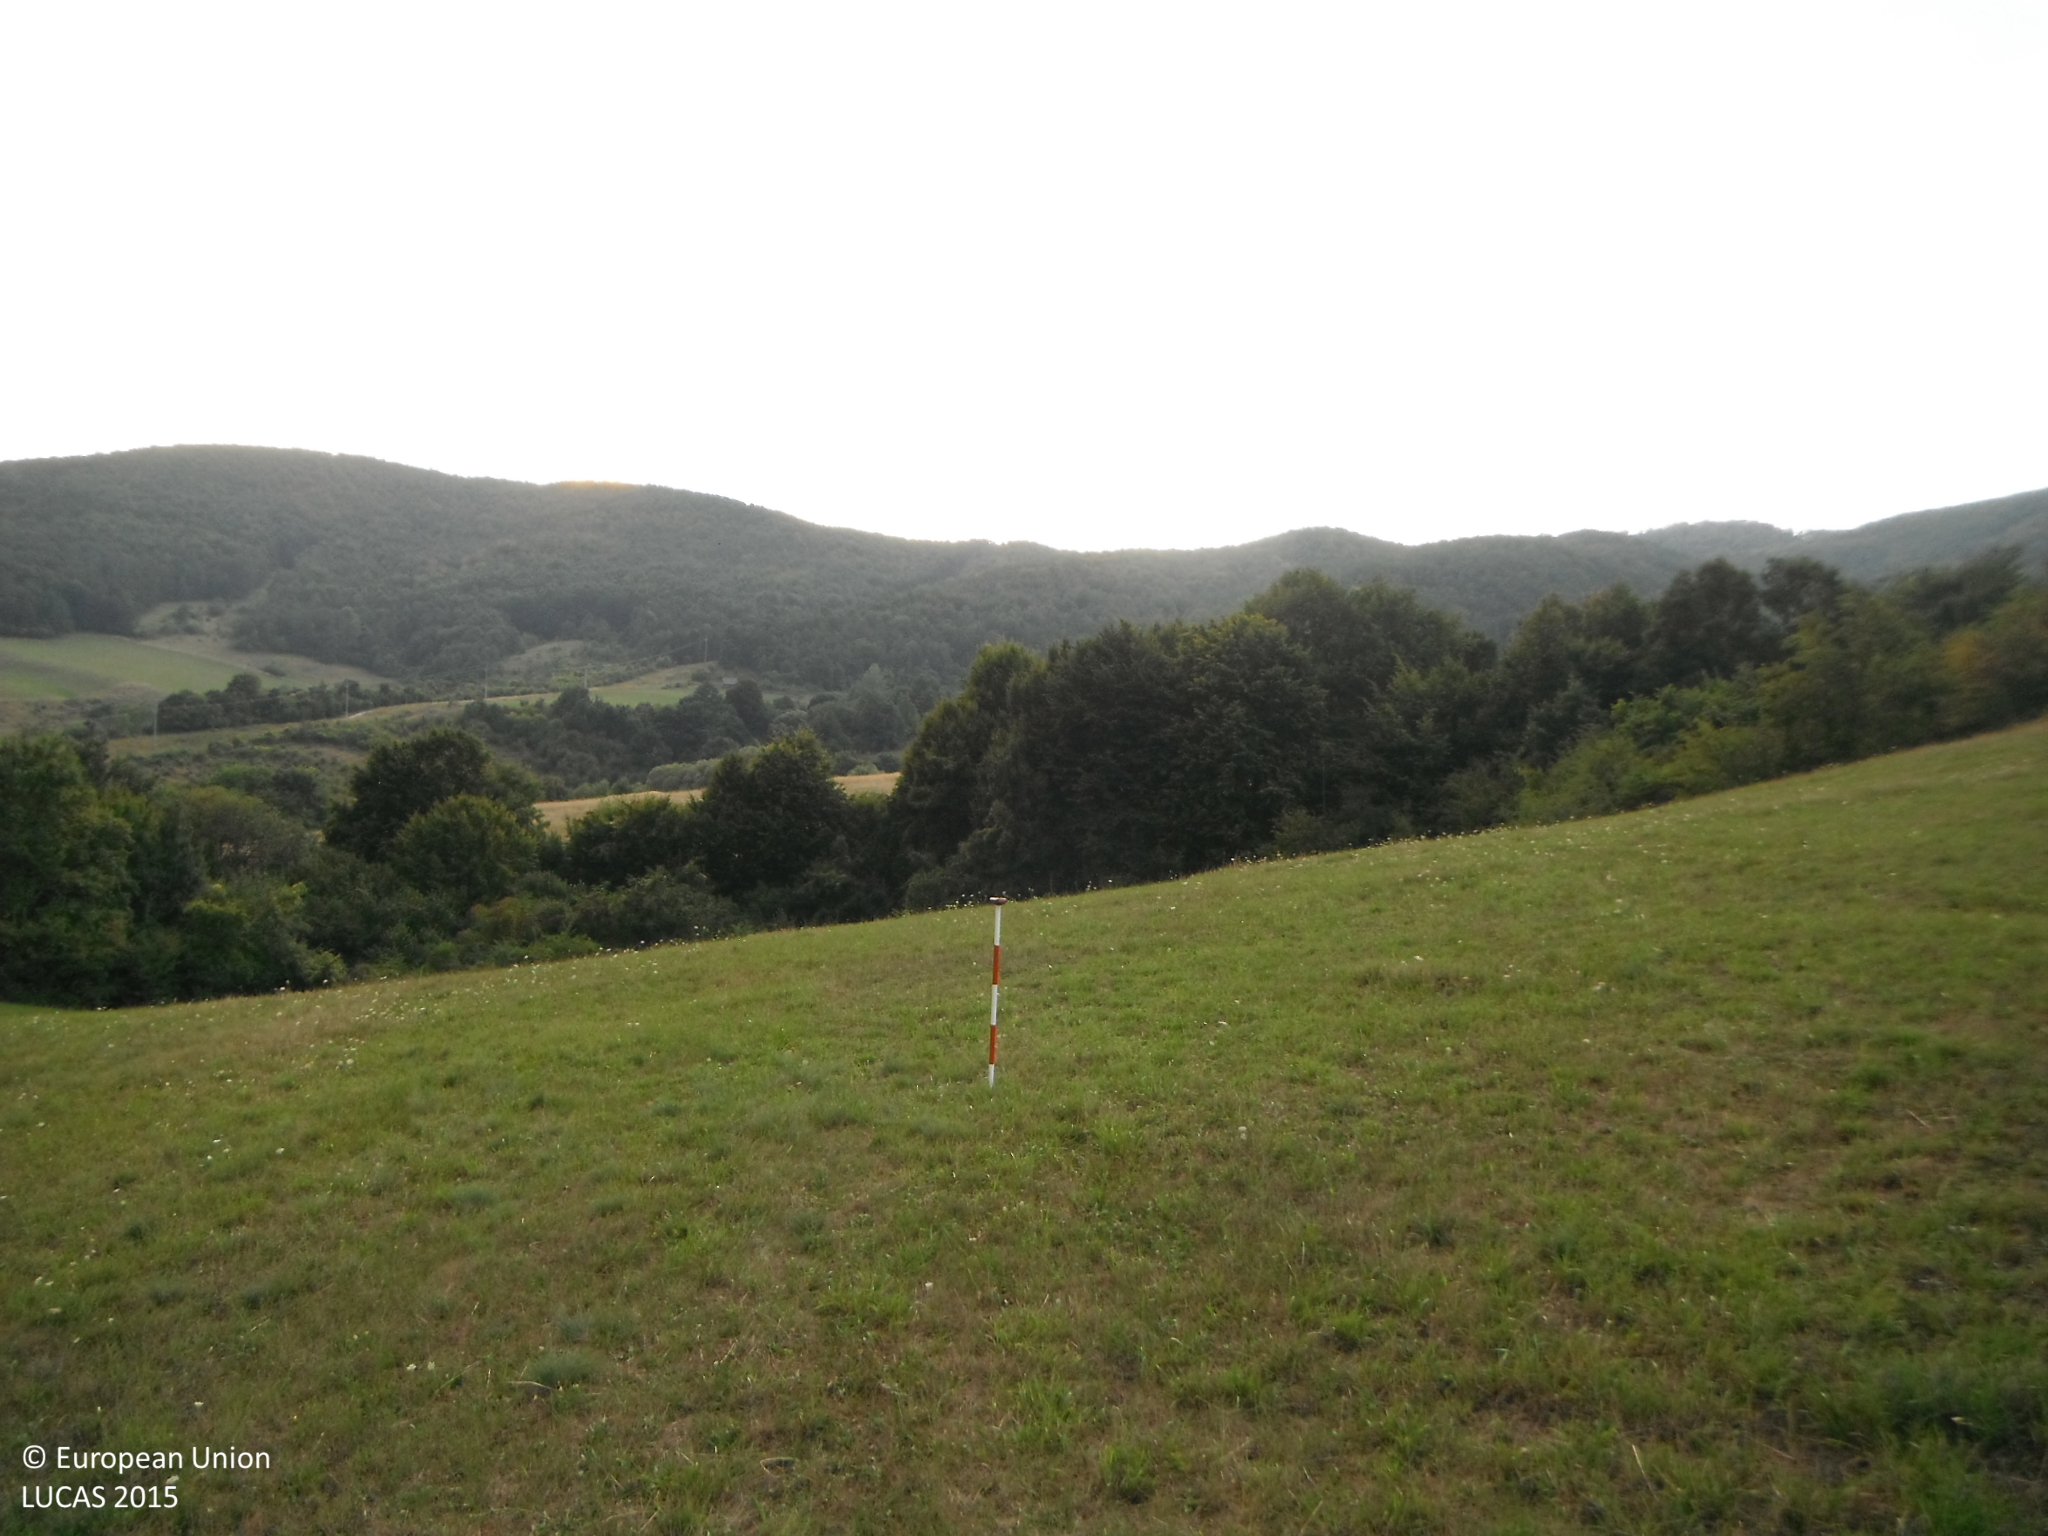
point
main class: Grassland
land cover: Grassland without tree/shrub cover
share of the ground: > 75 %
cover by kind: herbaceous plants 100 %
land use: Agriculture (excluding fallow land and kitchen gardens)
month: August
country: SK
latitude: 48.8117
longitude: 18.3366
